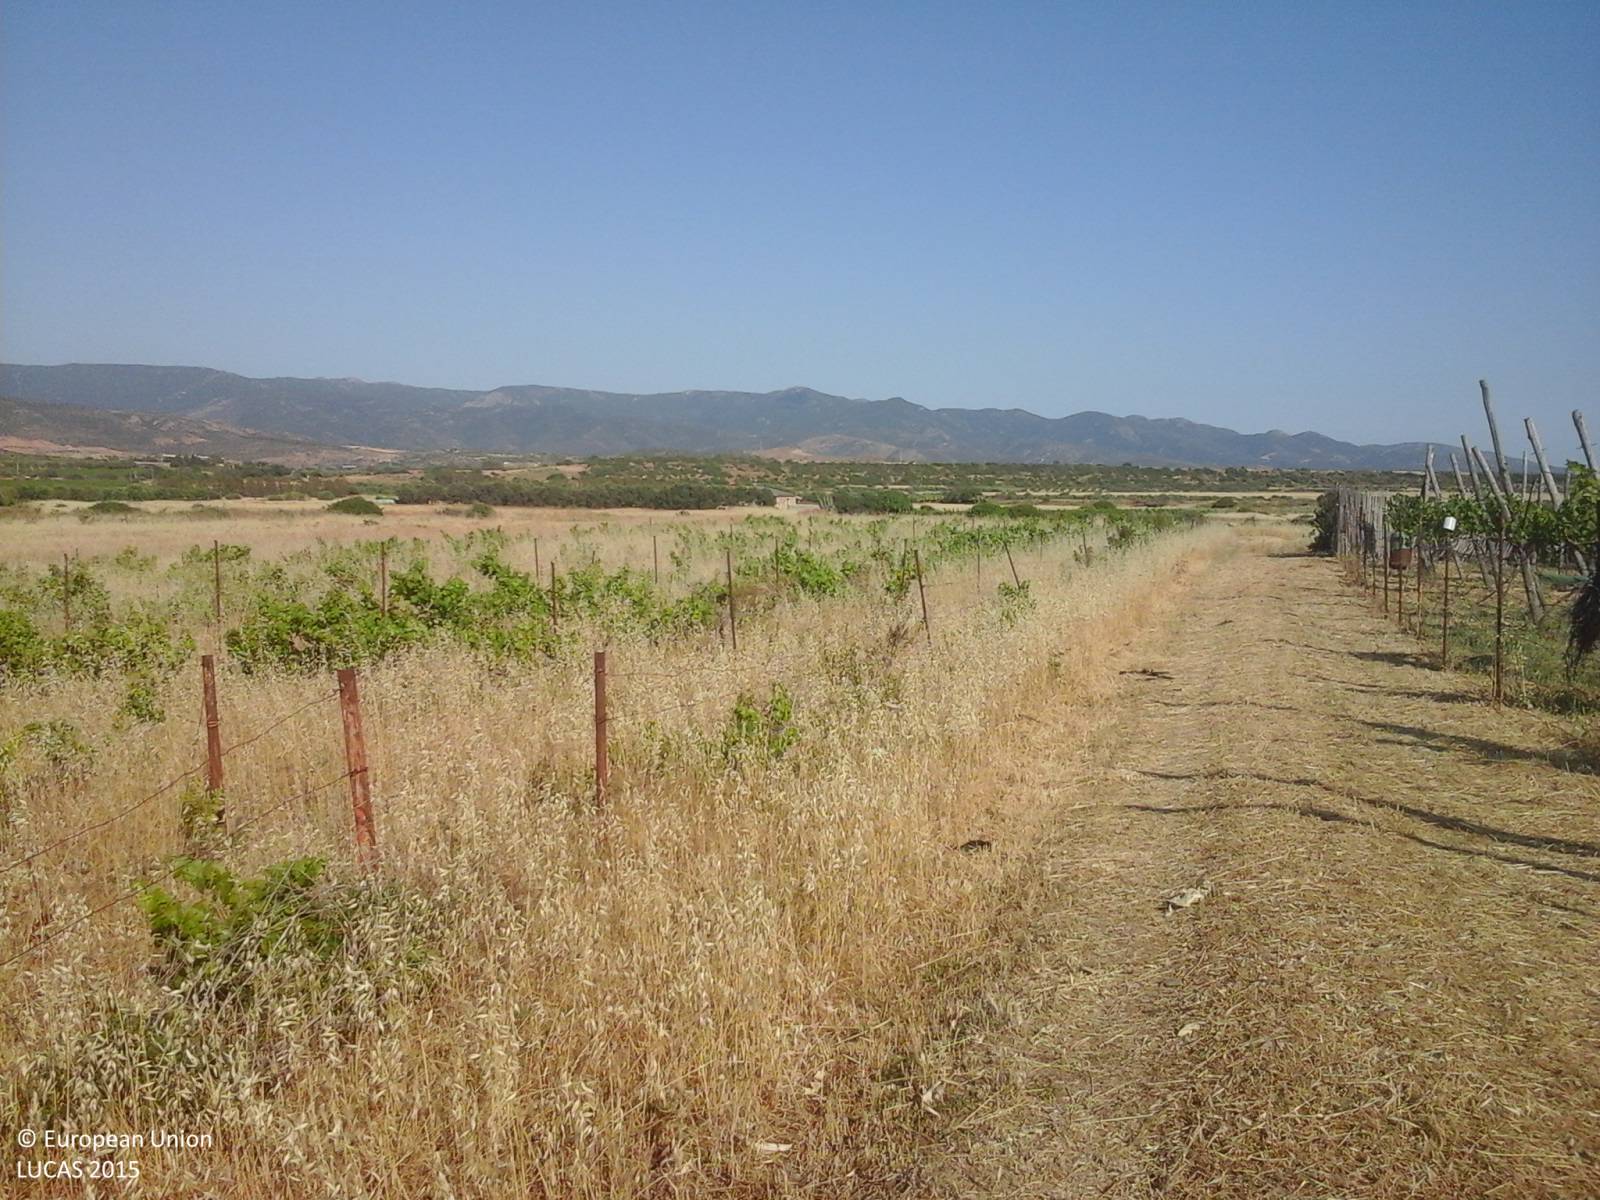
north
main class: Cropland
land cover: Vineyards
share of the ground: 50 - 75 %
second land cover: Oats
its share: 50 - 75 %
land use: Agriculture (excluding fallow land and kitchen gardens)
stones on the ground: 25 - 50 %
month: June
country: IT
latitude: 39.2864
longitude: 9.2510
